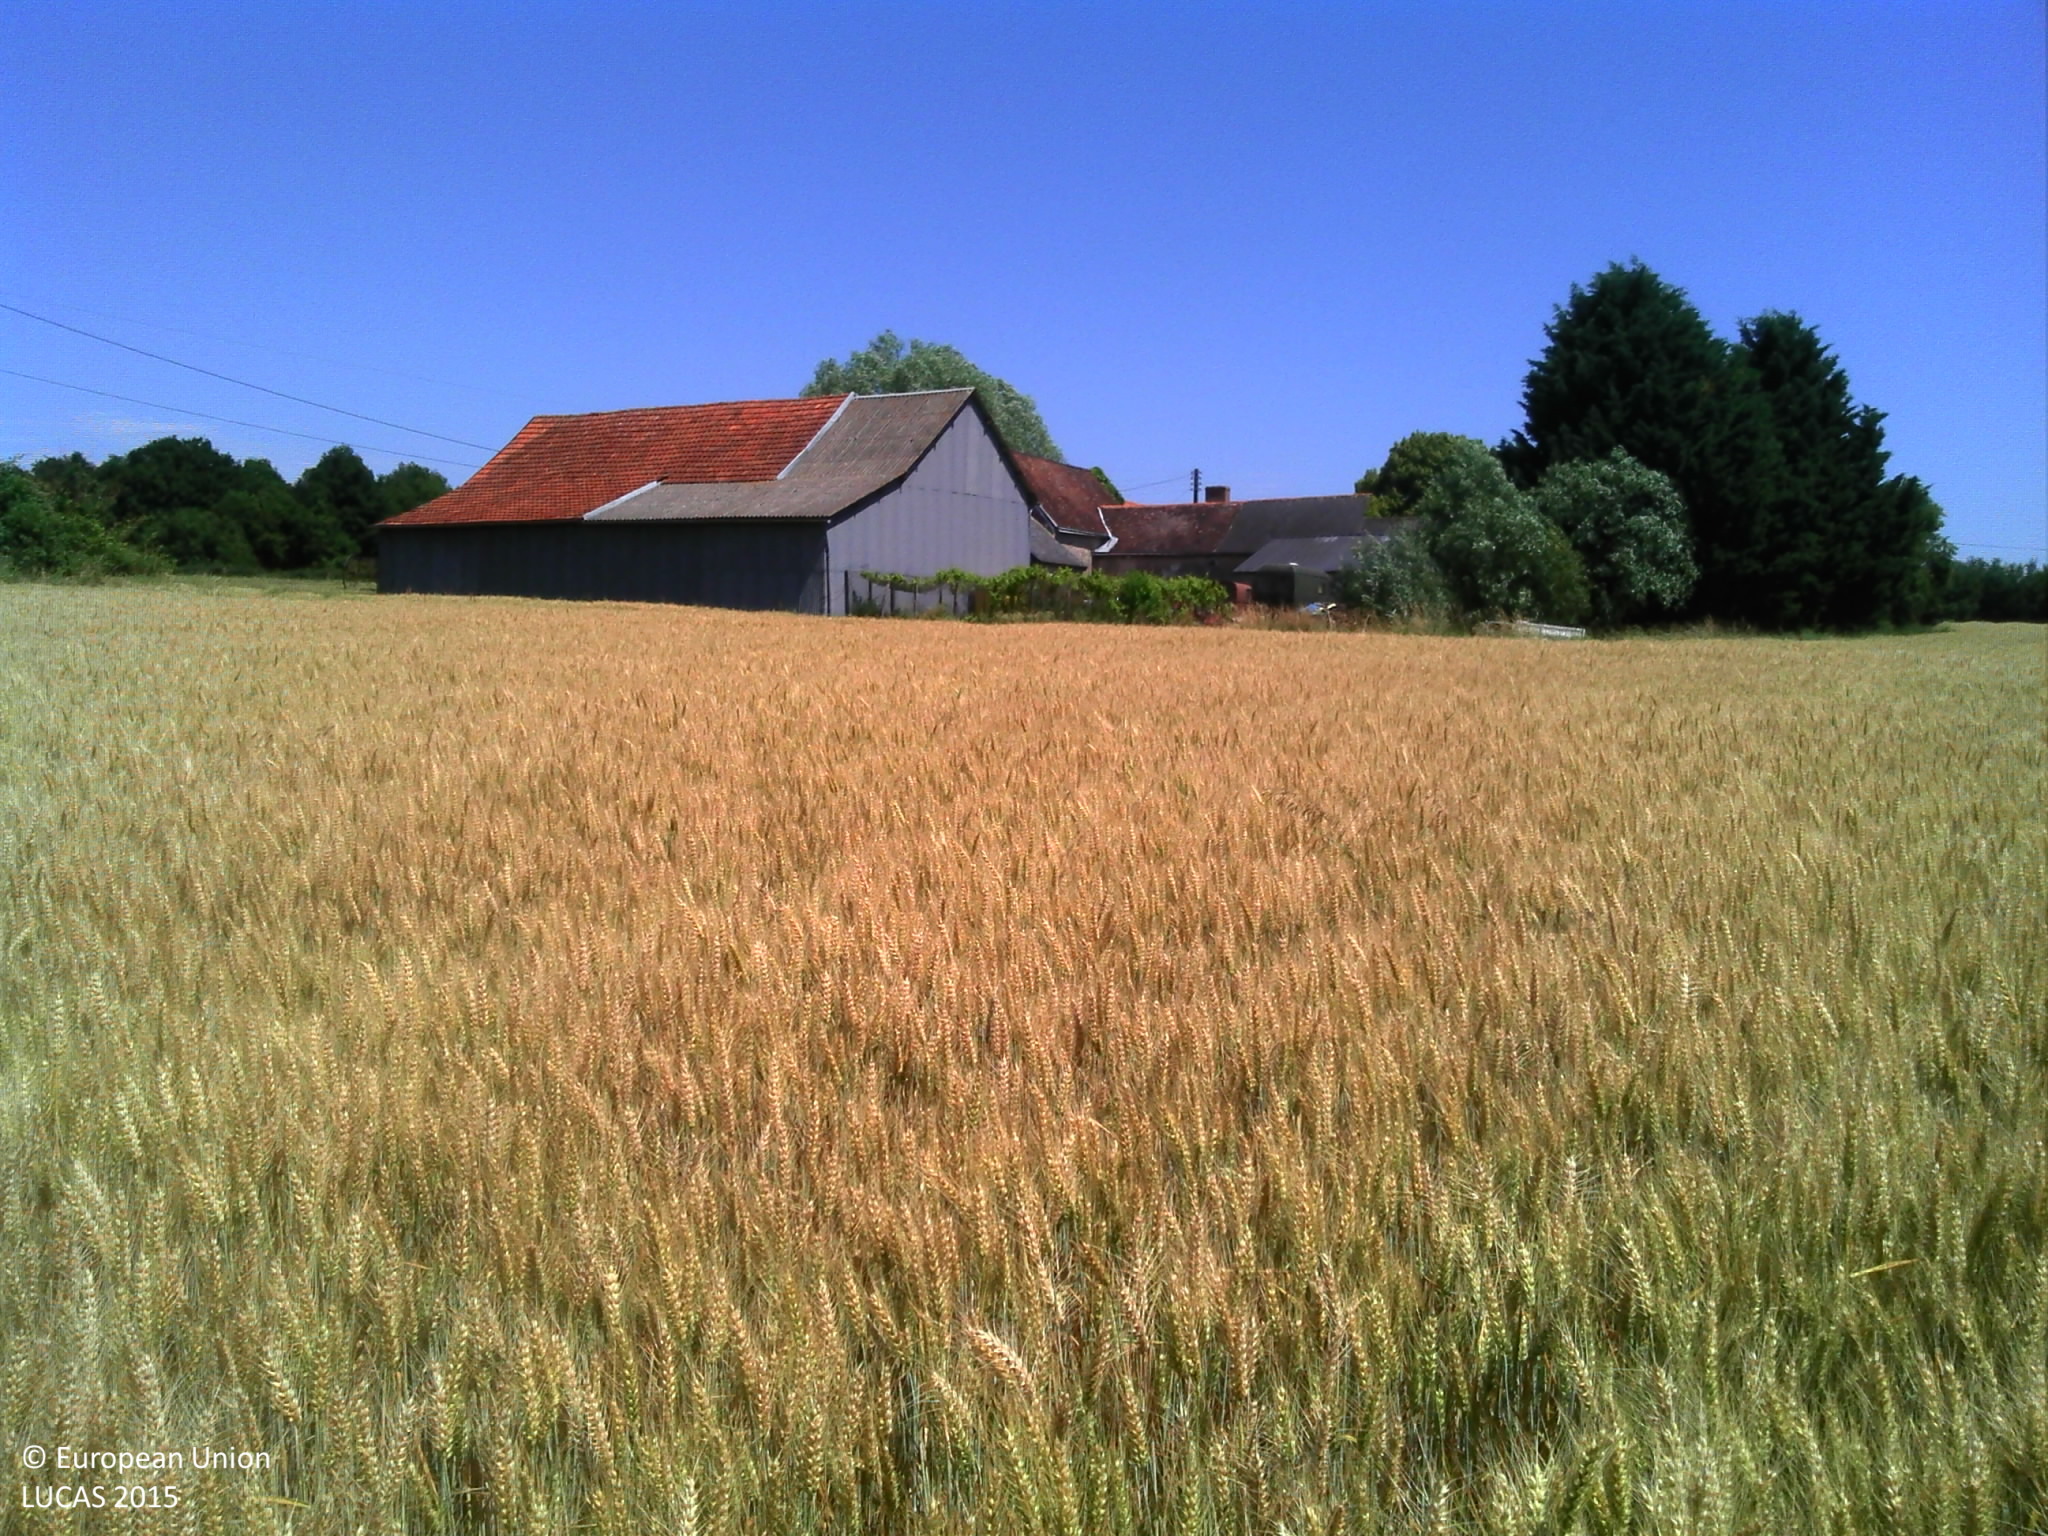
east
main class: Cropland
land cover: Durum wheat
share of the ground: > 75 %
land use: Agriculture (excluding fallow land and kitchen gardens)
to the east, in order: Durum wheat; Artificial constructions in urban areas; Abandoned hedges; Grassland without tree/shrub cover; Electric lines; Grassland without tree/shrub cover; Abandoned hedges; Fences; Ditches and canals; Grass margins; Paved roads, cycling and walking lanes; Grass margins; Ditches and canals; Electric lines; Fences; Single bushes/trees; Grassland without tree/shrub cover
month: June
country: FR
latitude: 47.5023
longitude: 0.2719
